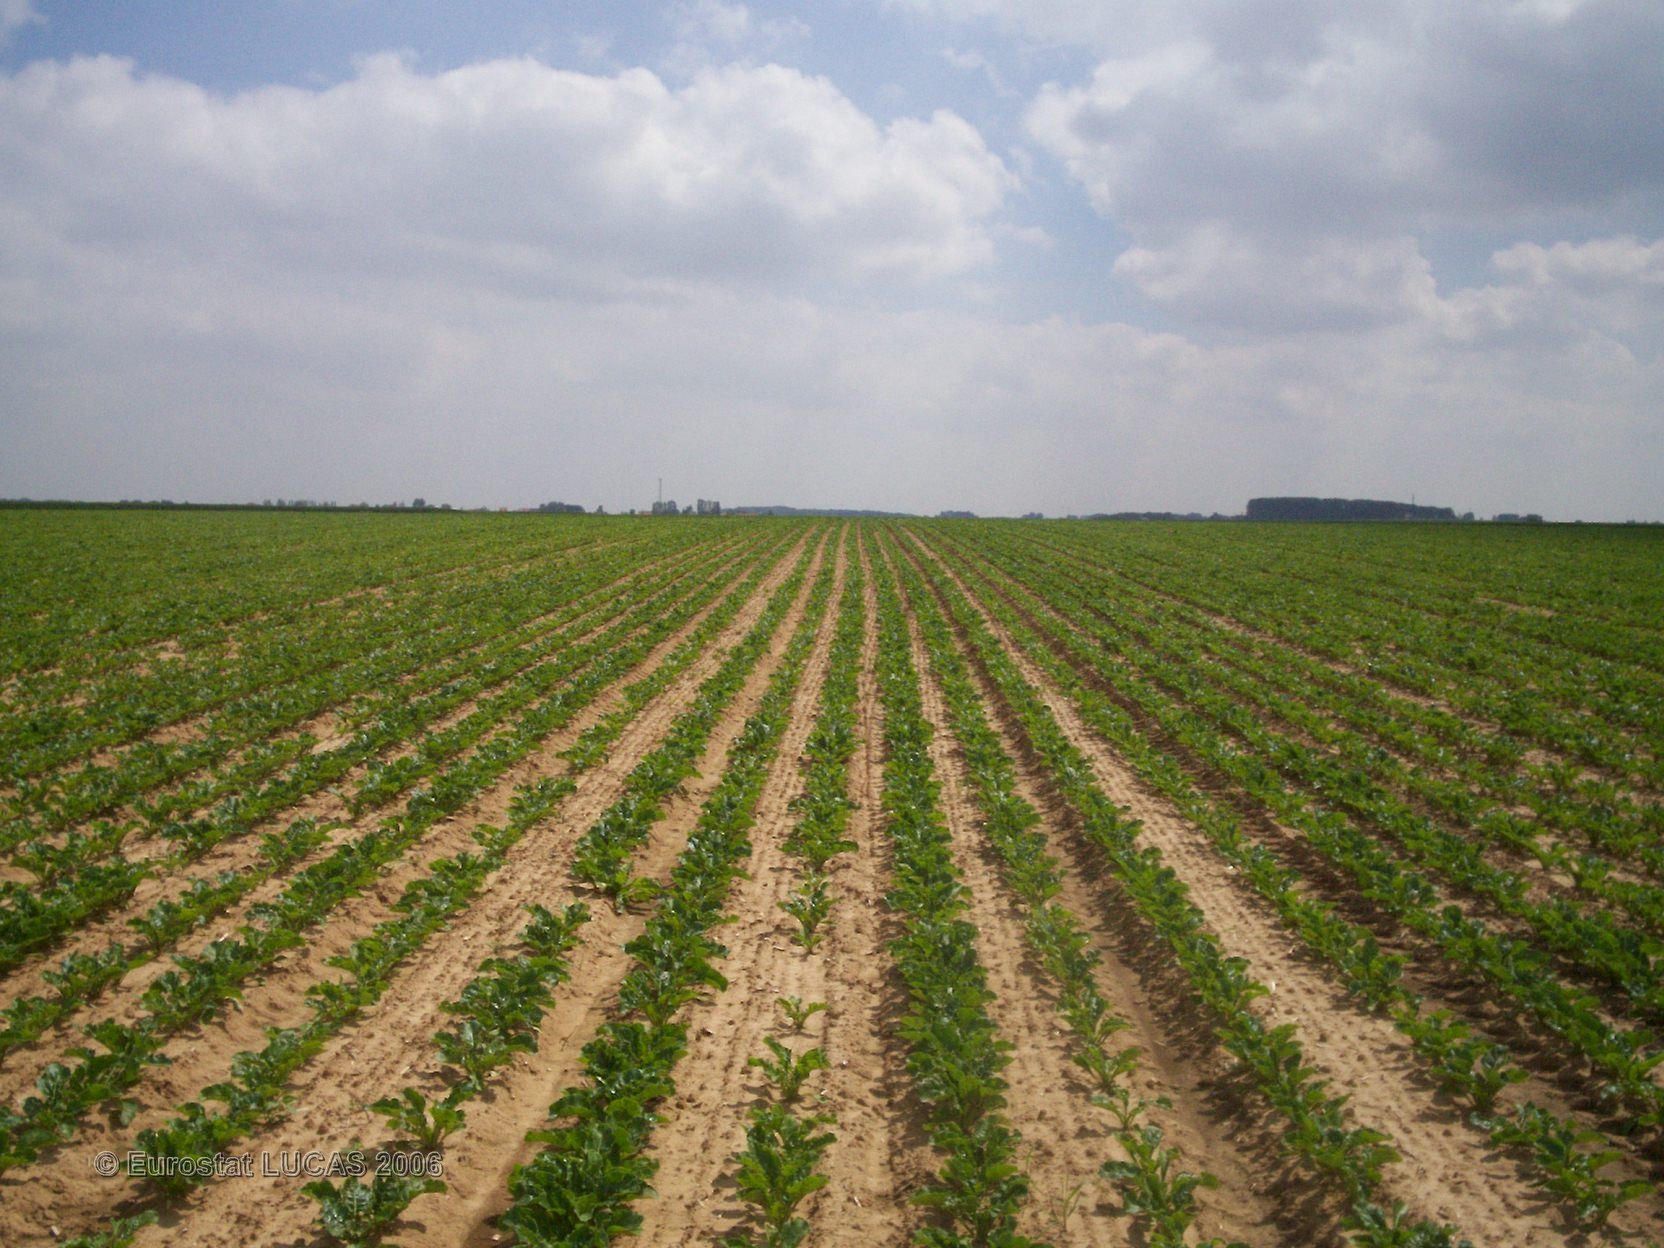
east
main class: Cropland
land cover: Sugar beet
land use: Agriculture (excluding fallow land and kitchen gardens)
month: June
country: FR
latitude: 49.8768
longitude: 2.6831
